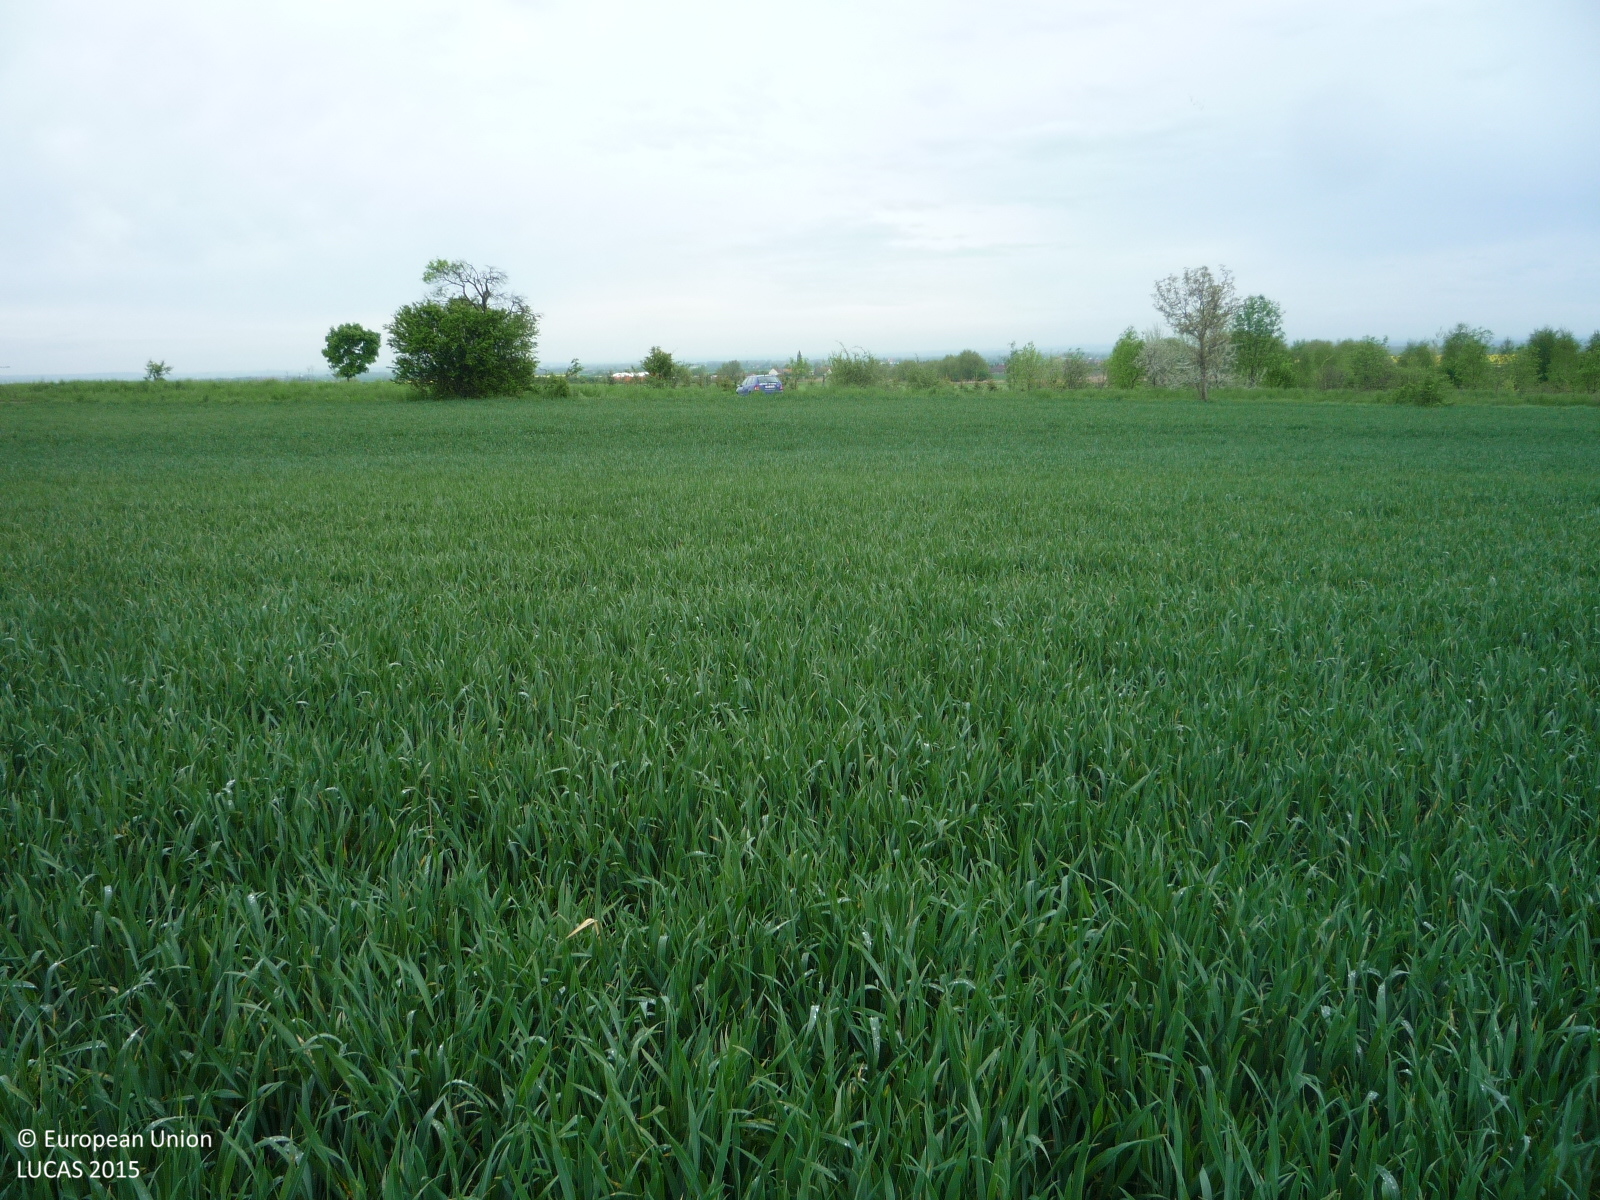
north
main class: Cropland
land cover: Common wheat
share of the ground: > 75 %
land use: Agriculture (excluding fallow land and kitchen gardens)
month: May
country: CZ
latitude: 50.2416
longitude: 14.4465
